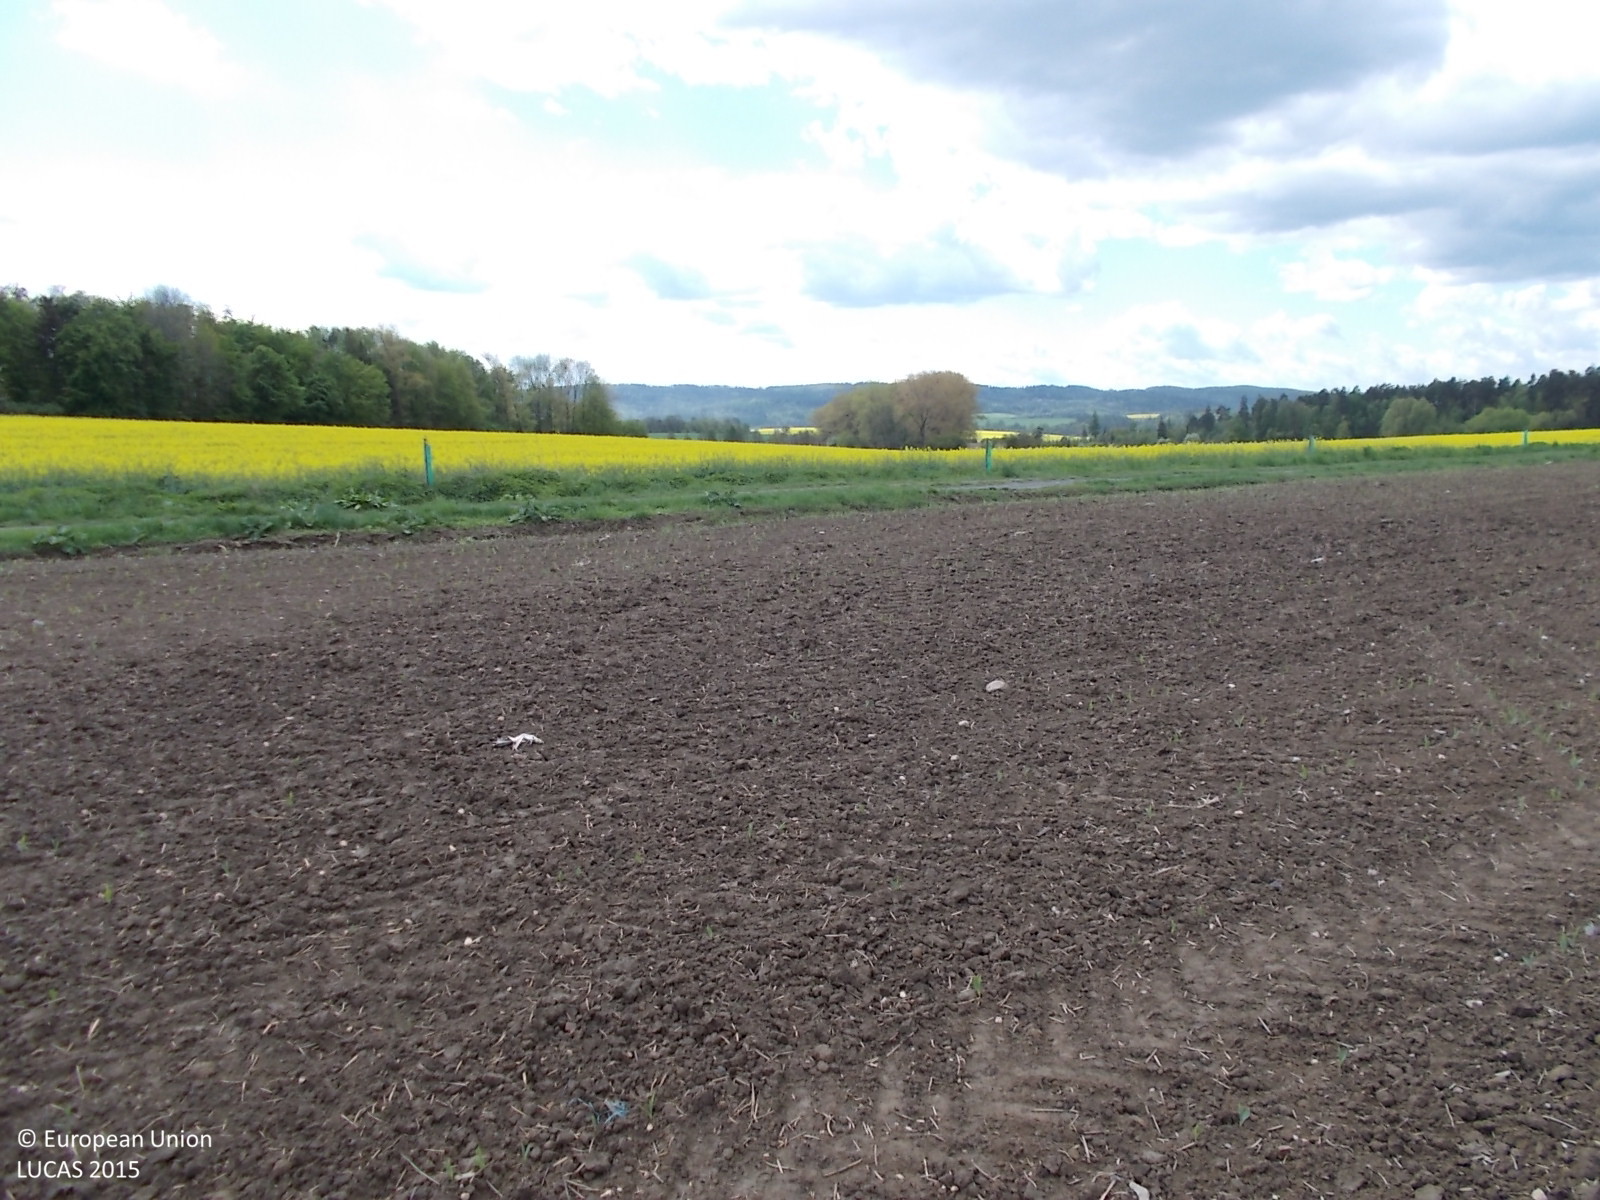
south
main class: Cropland
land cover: Maize
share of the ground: < 10 %
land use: Agriculture (excluding fallow land and kitchen gardens)
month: May
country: CZ
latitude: 49.9225
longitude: 17.7162
